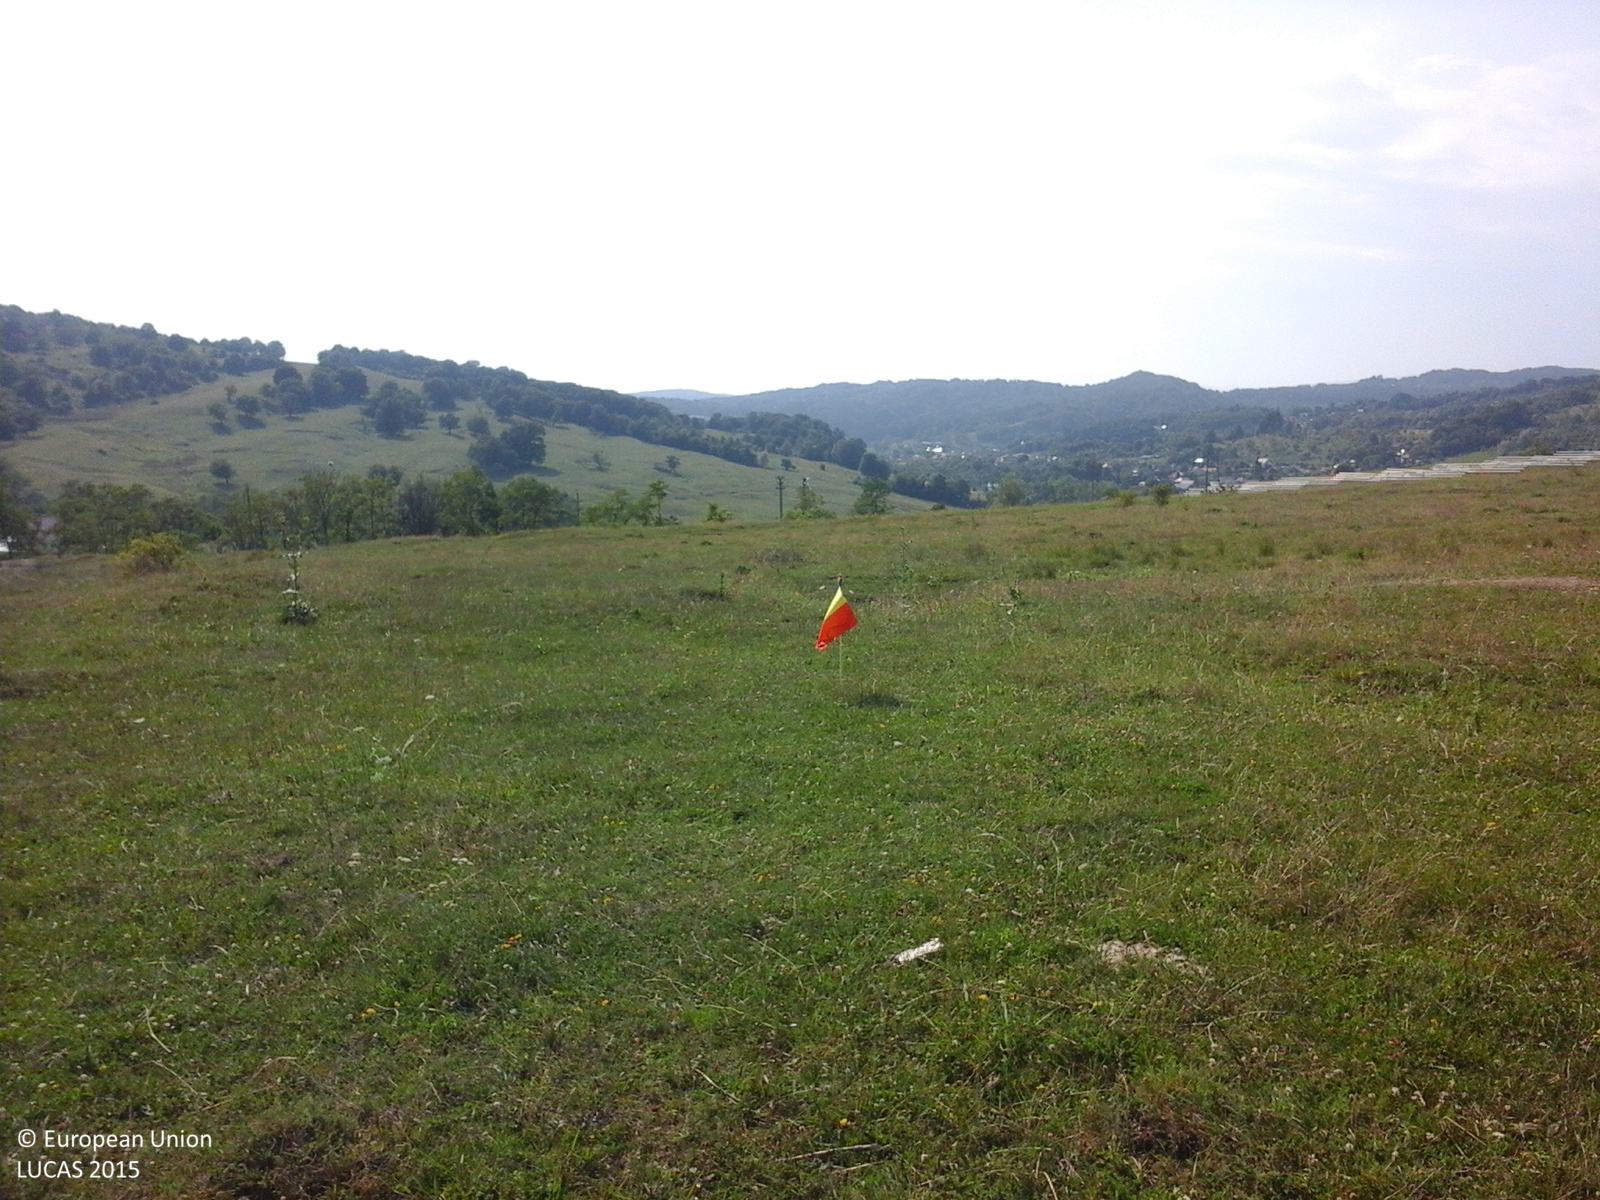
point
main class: Grassland
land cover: Grassland without tree/shrub cover
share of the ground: > 75 %
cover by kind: herbaceous plants 100 %
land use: Agriculture (excluding fallow land and kitchen gardens)
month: July
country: RO
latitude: 45.1783
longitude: 24.7284
